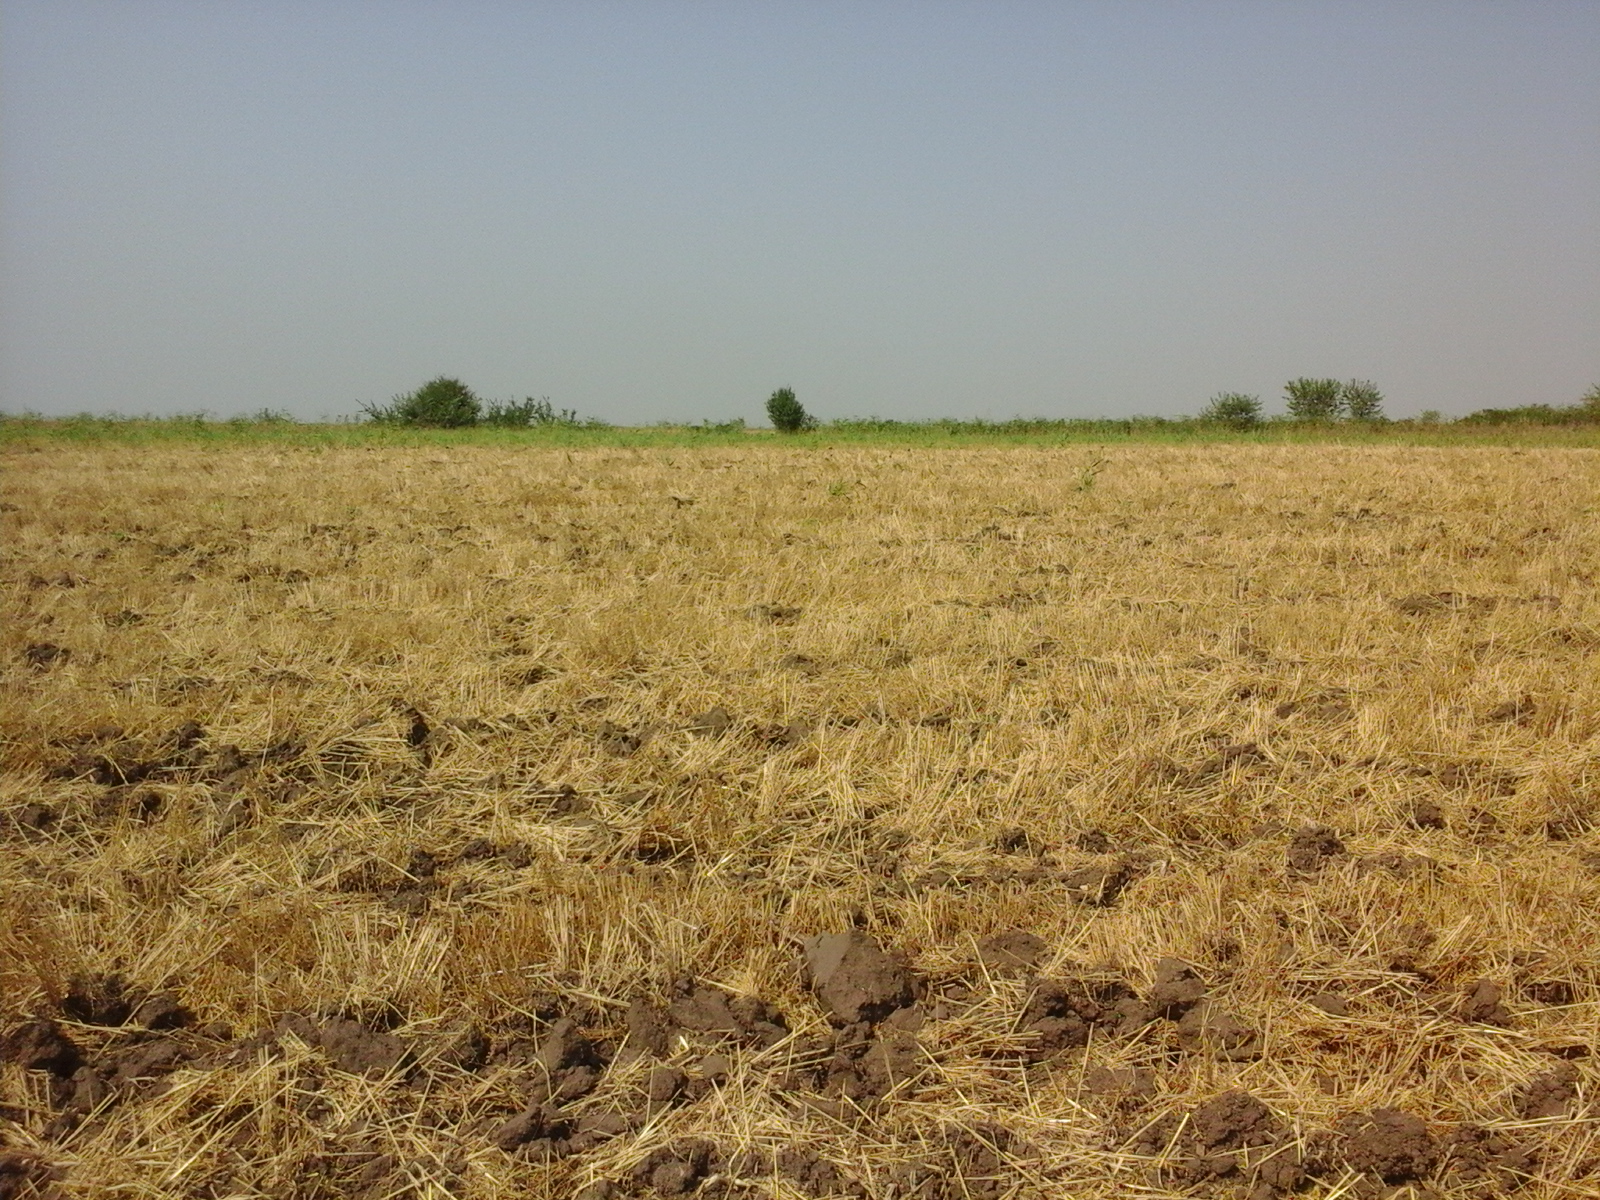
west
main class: Cropland
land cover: Common wheat
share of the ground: 50 - 75 %
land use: Agriculture (excluding fallow land and kitchen gardens)
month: August
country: RO
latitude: 43.9060
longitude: 23.3311
